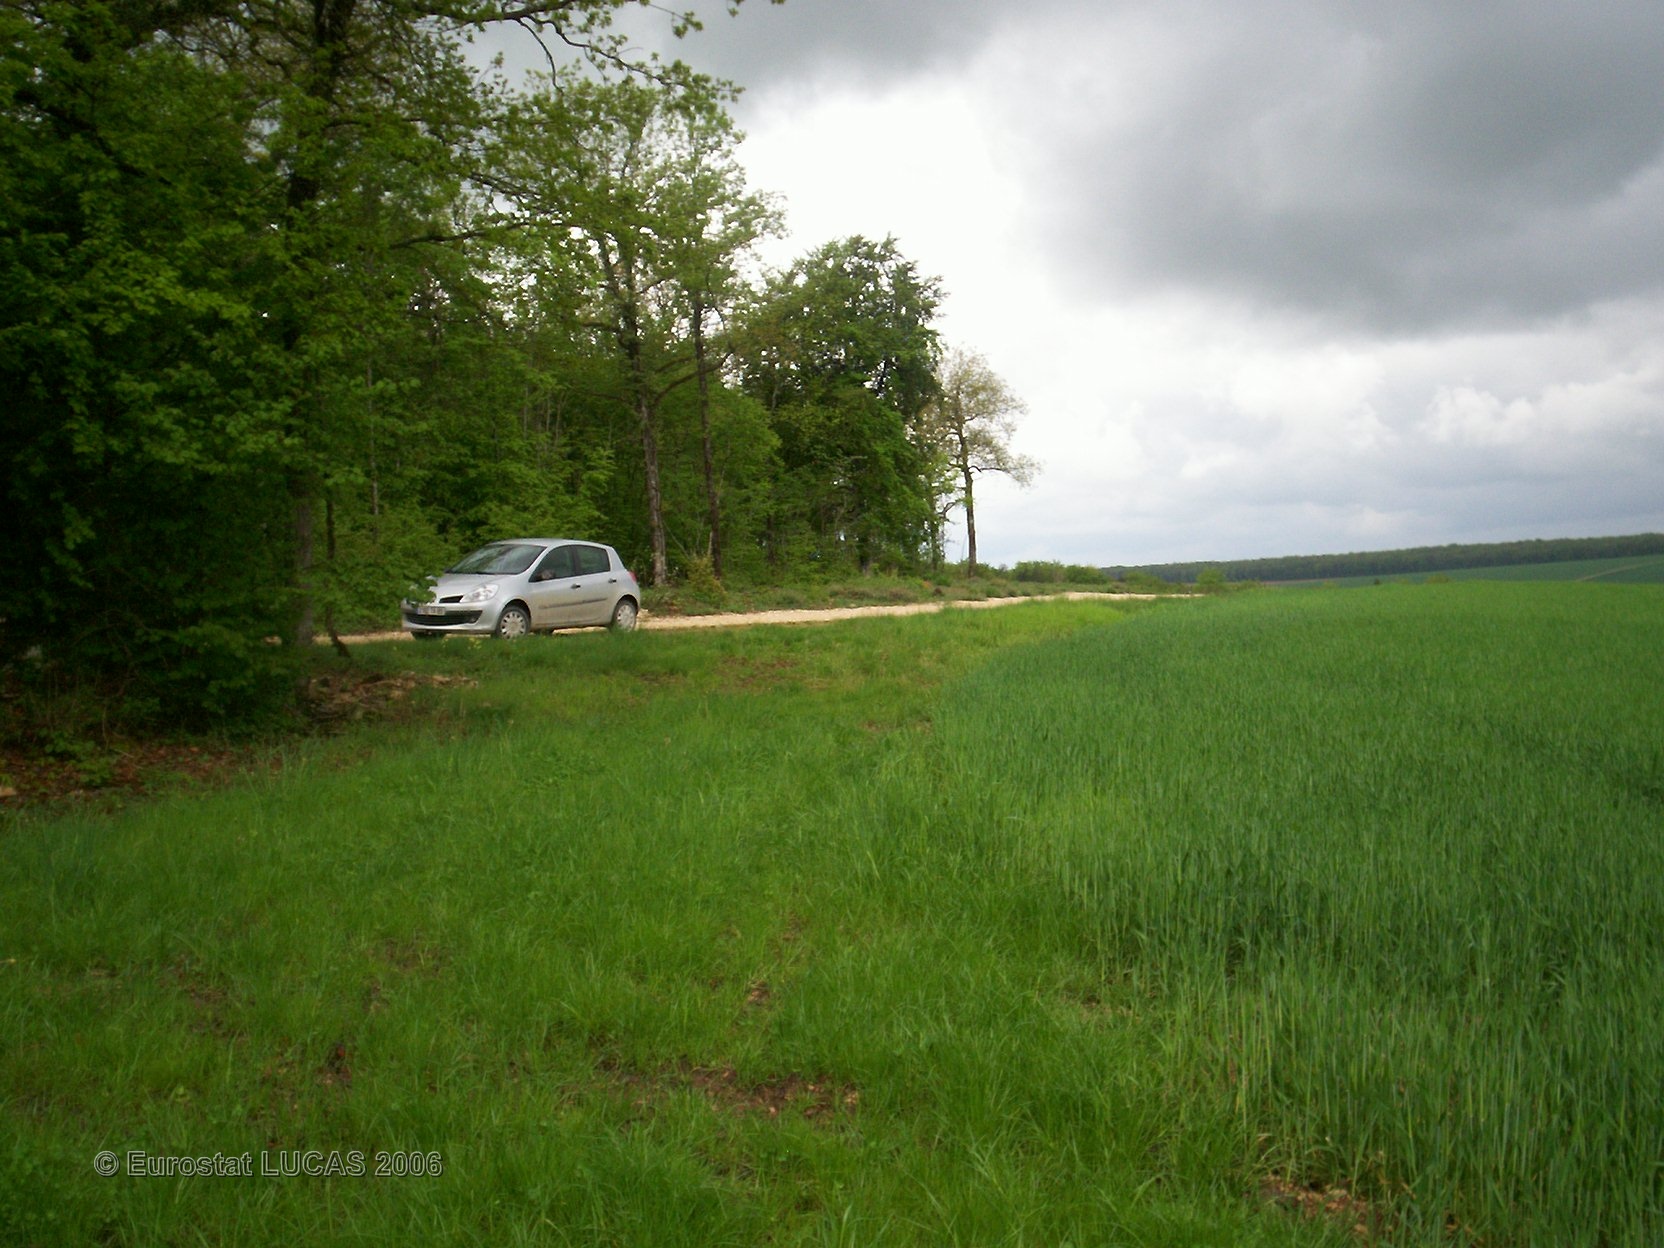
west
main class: Grassland
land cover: Grassland without tree/shrub cover
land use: Agriculture (excluding fallow land and kitchen gardens)
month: May
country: FR
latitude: 47.7663
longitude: 4.5950
